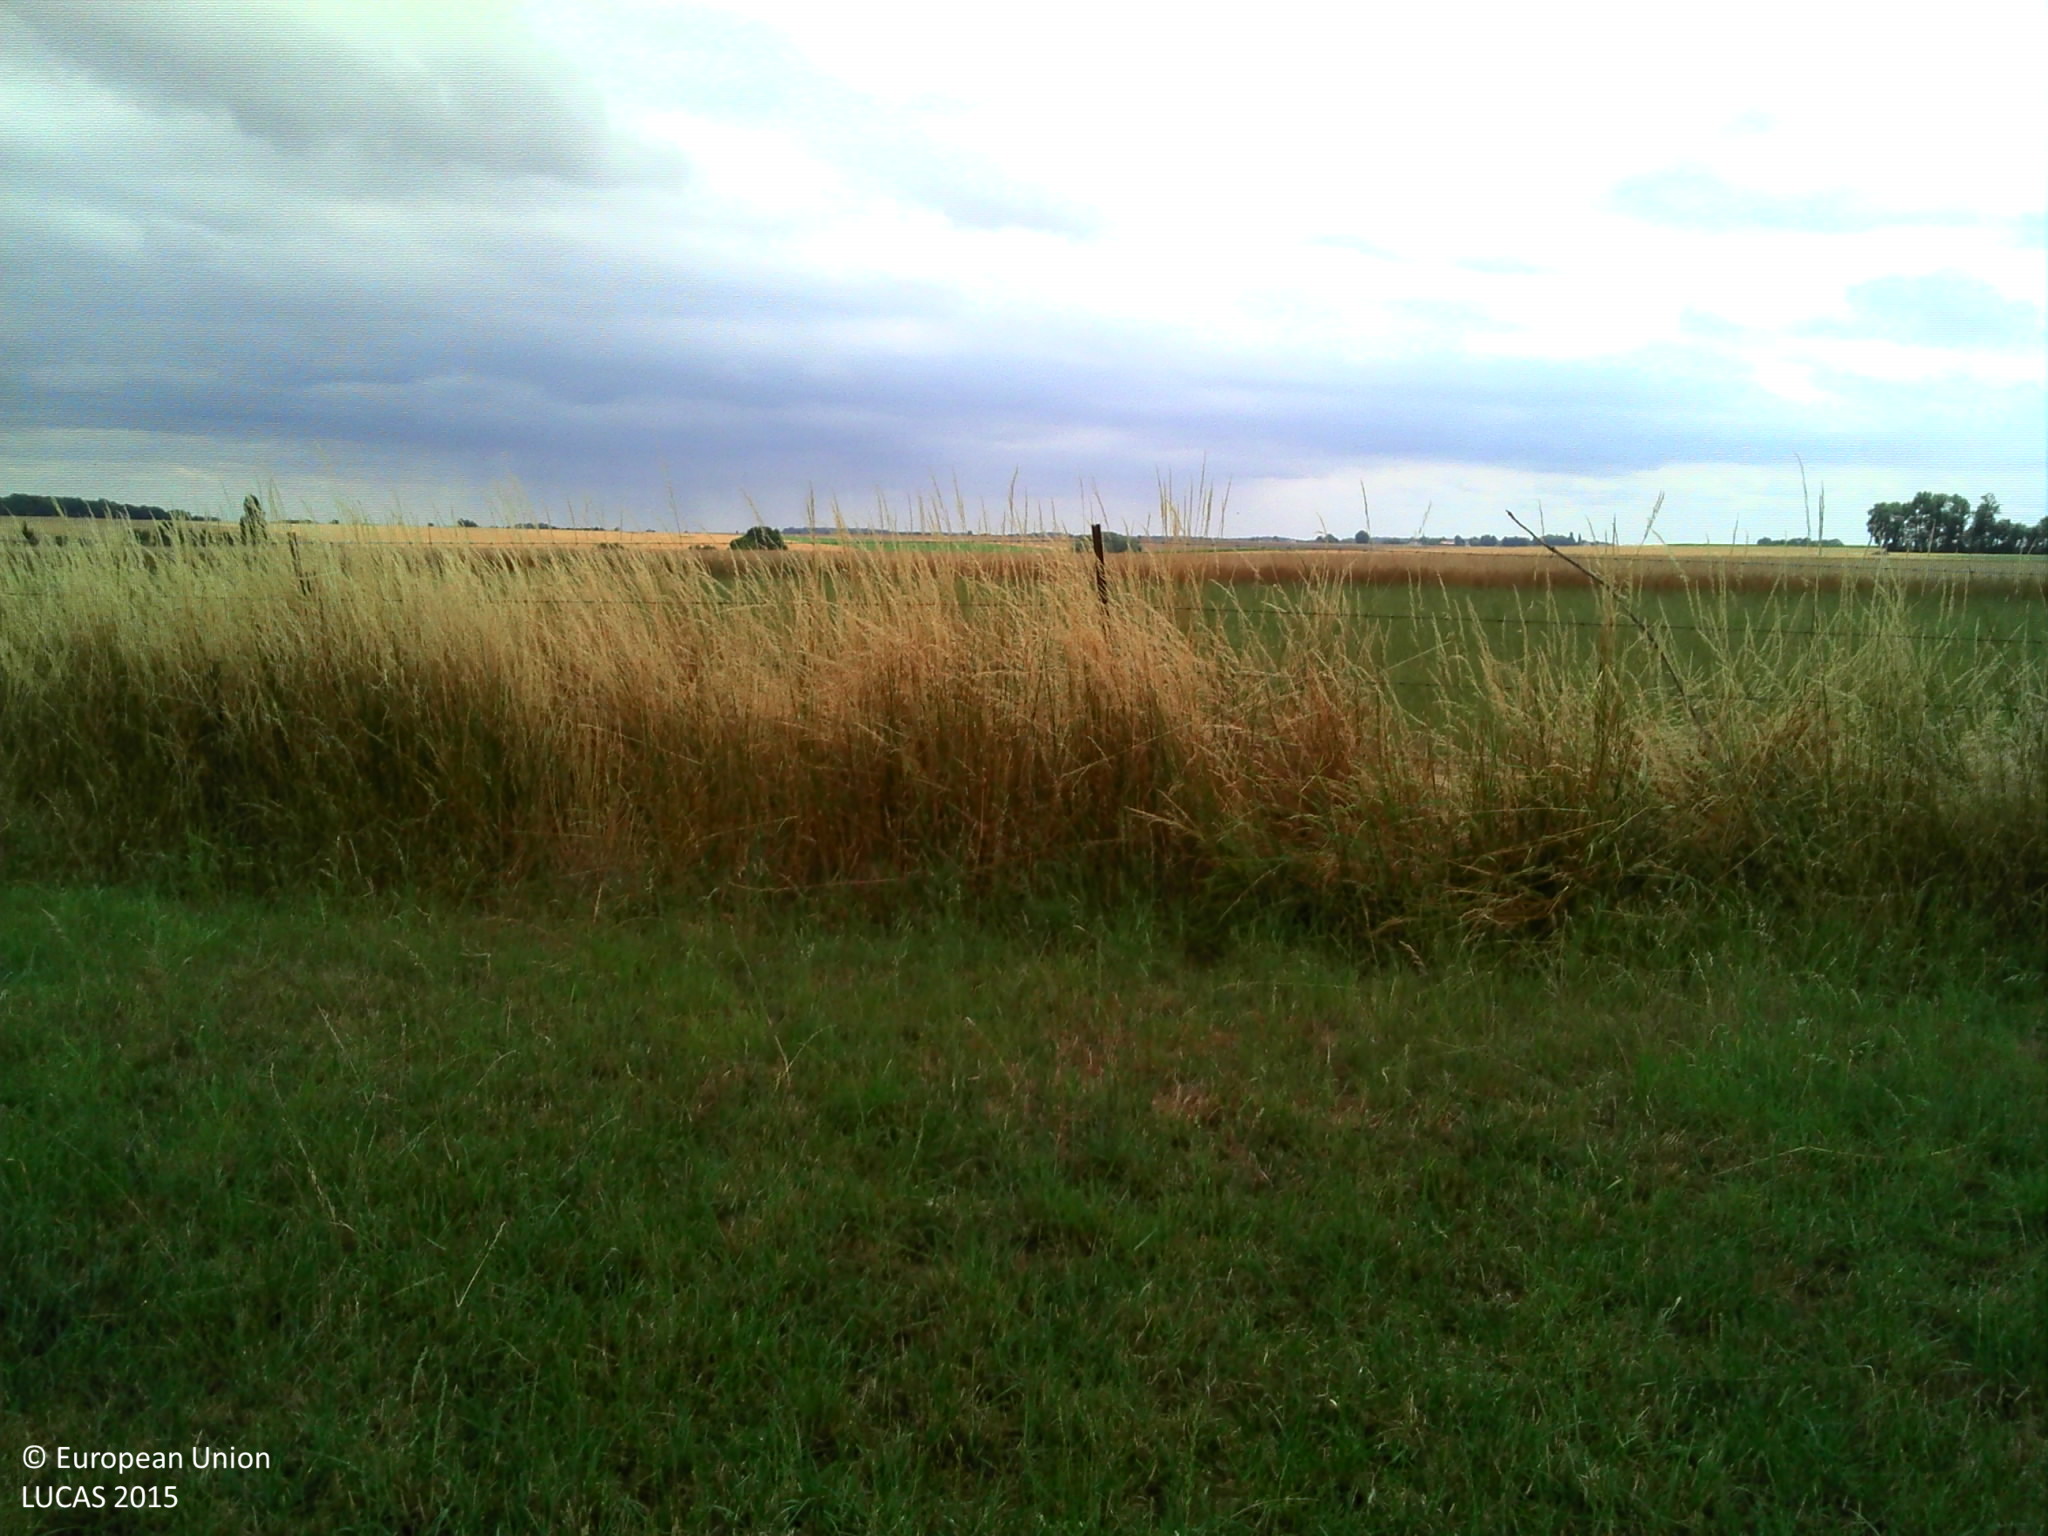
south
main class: Grassland
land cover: Grassland without tree/shrub cover
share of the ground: > 75 %
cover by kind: herbaceous plants 100 %
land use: Agriculture (excluding fallow land and kitchen gardens)
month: July
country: FR
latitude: 49.8153
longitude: 2.3011
